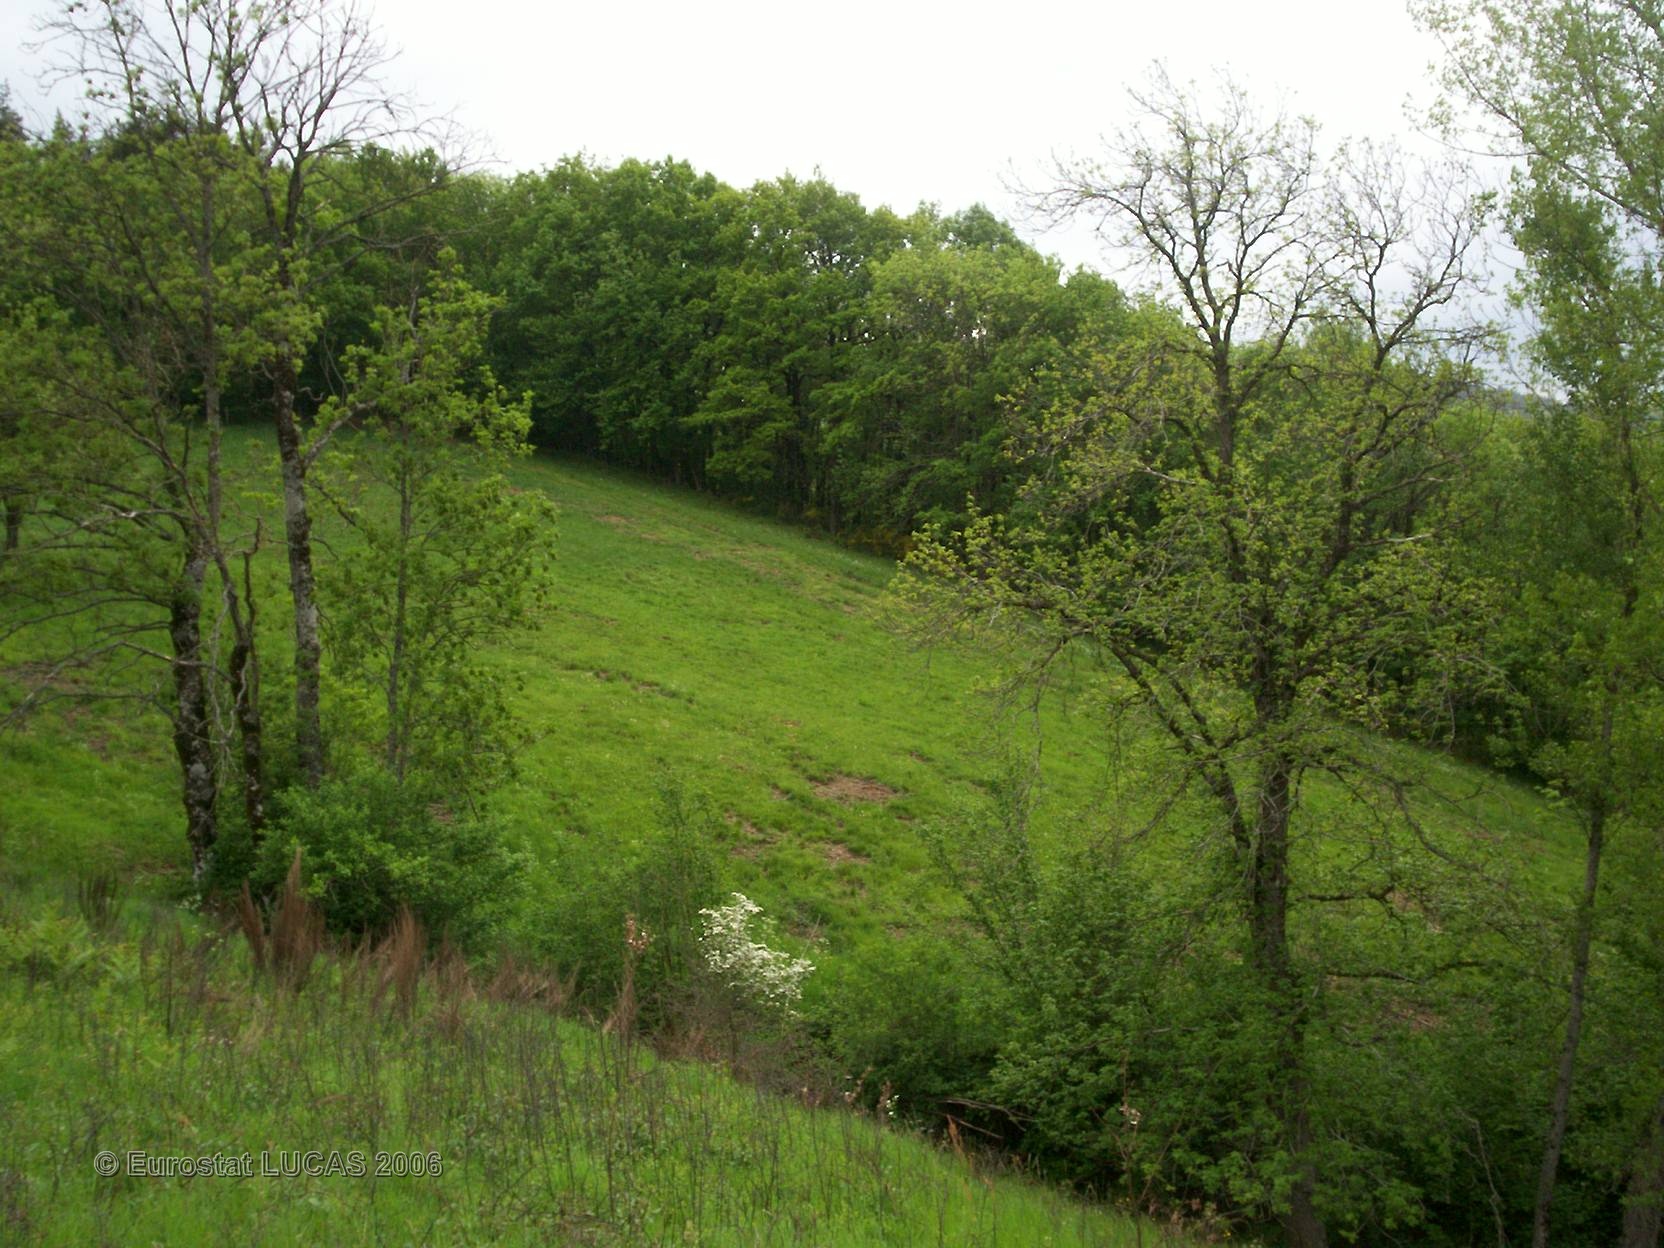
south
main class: Grassland
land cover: Grassland with sparse tree/shrub cover
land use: Agriculture (excluding fallow land and kitchen gardens)
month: May
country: FR
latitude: 43.9767
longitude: 3.3876
